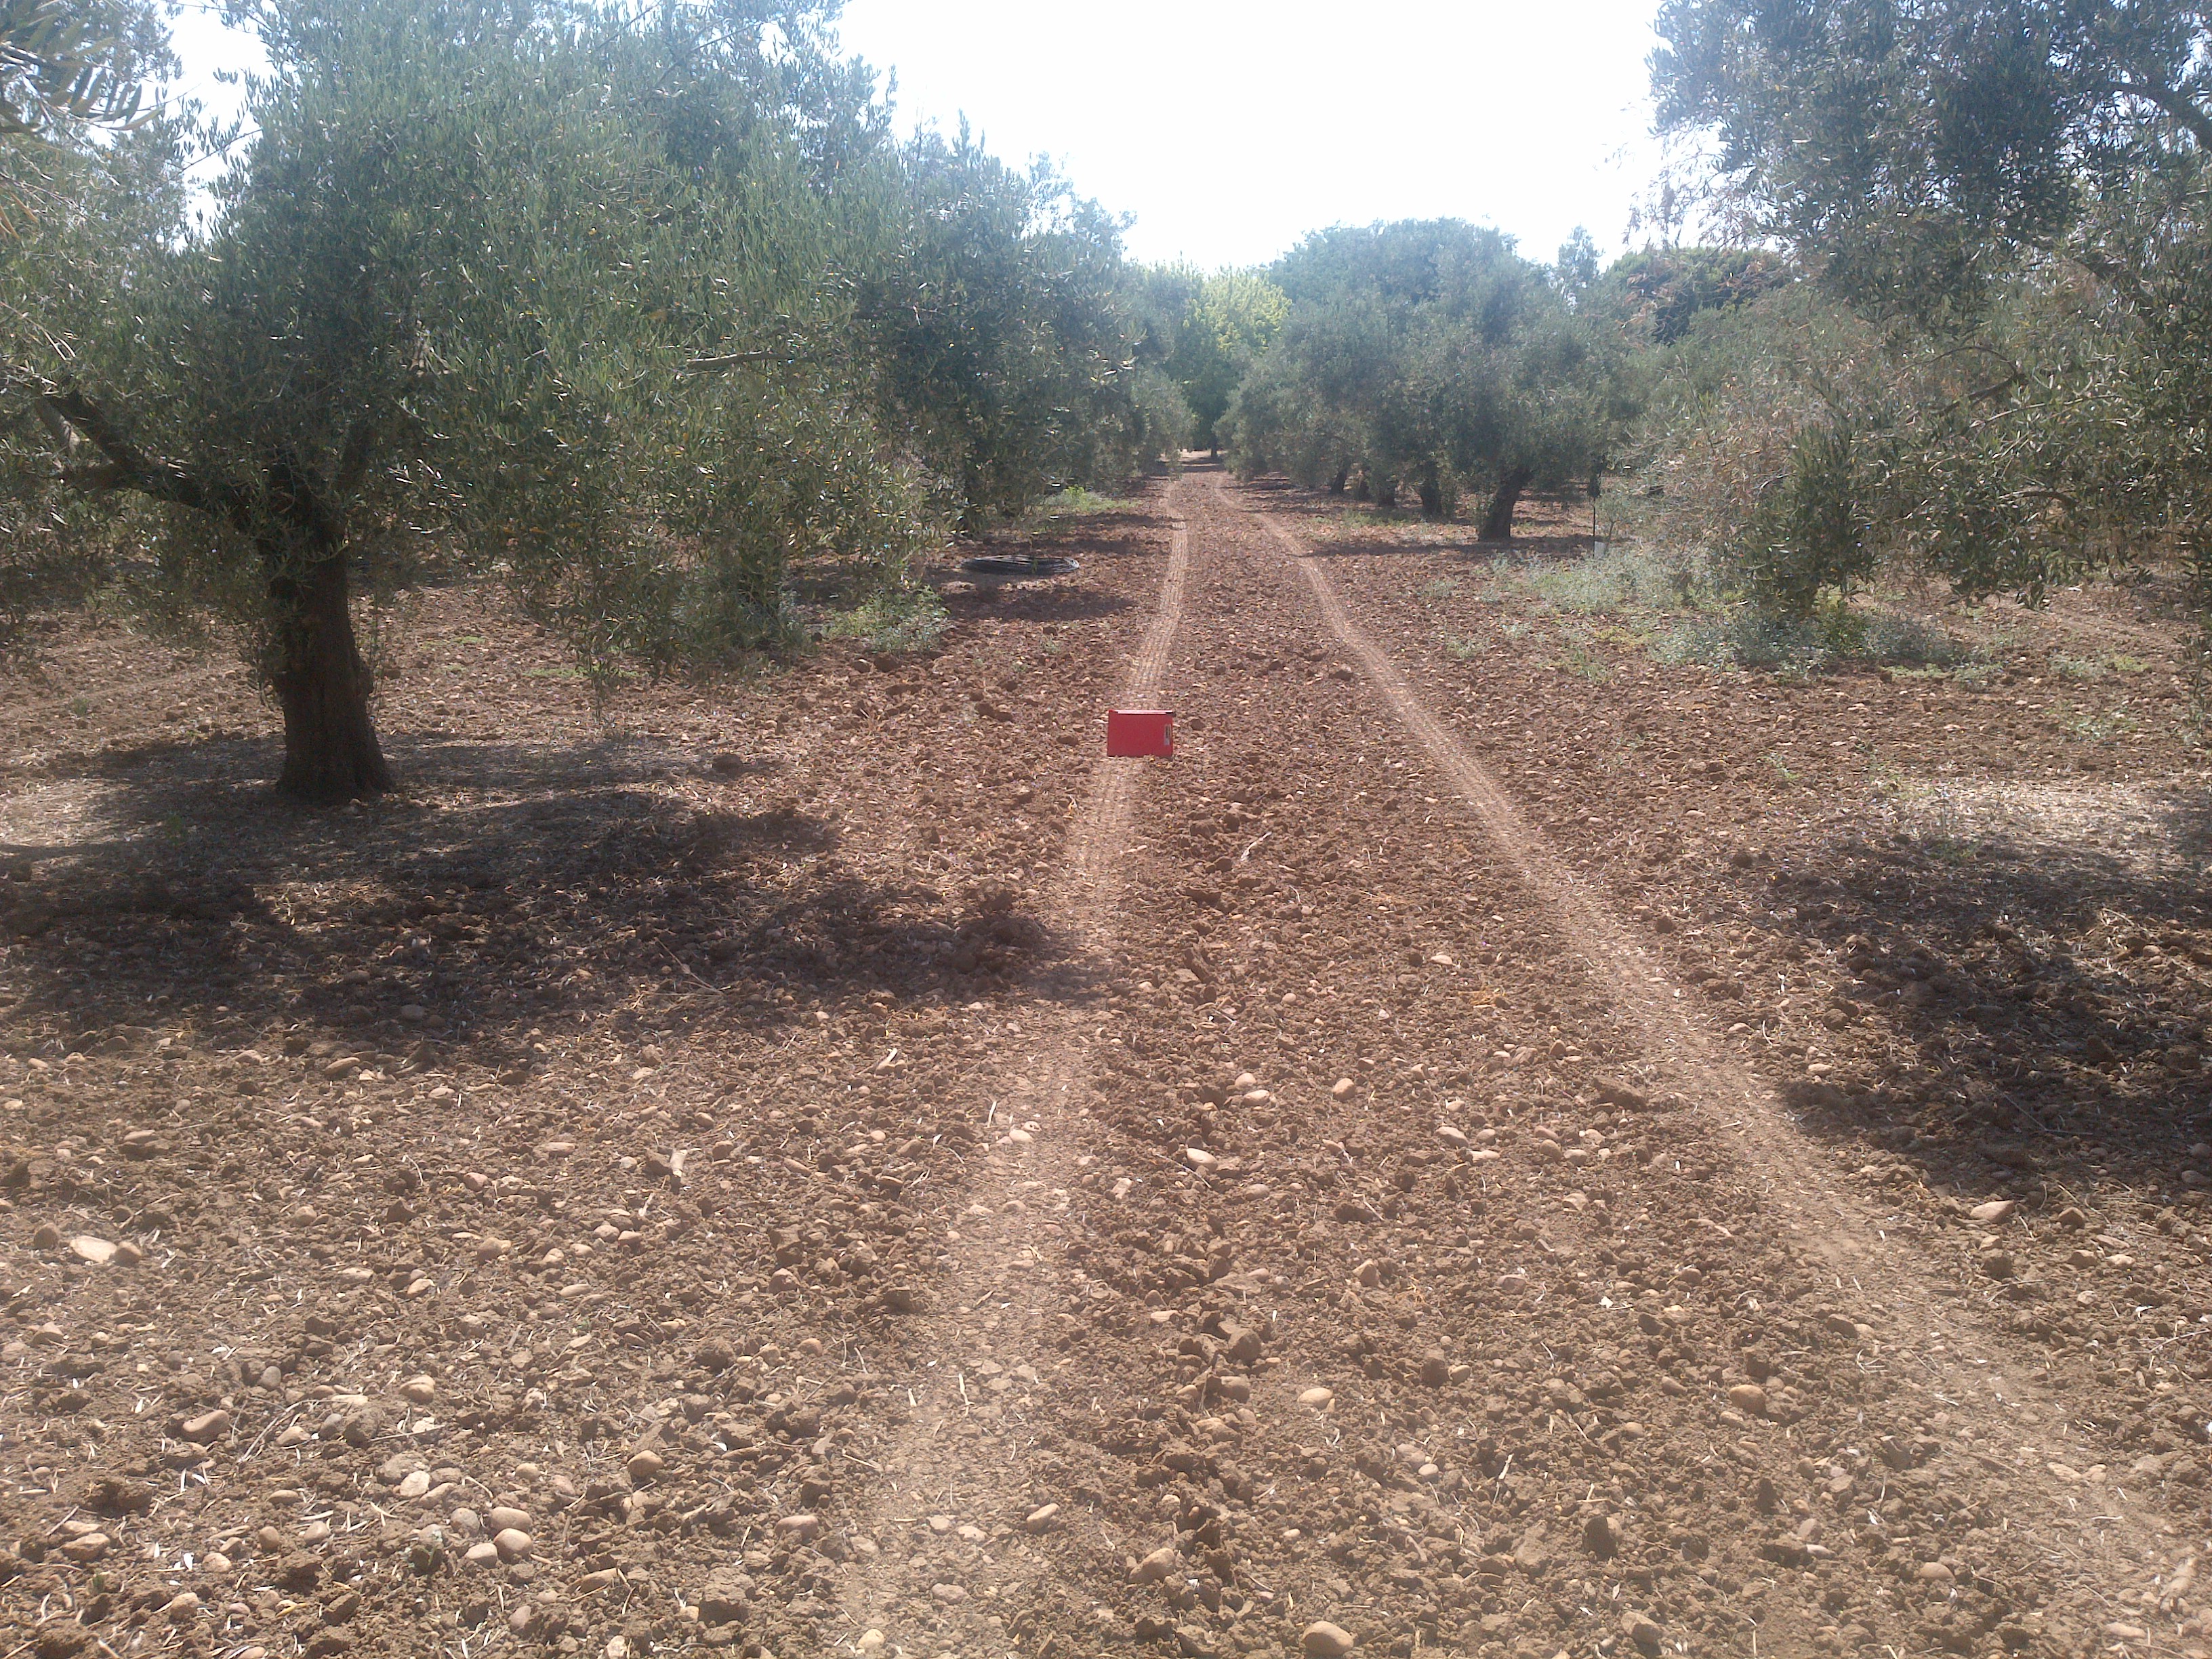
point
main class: Cropland
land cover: Olive groves
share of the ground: 50 - 75 %
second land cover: Other bare soil
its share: > 75 %
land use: Agriculture (excluding fallow land and kitchen gardens)
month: June
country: ES
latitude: 37.5854
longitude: -4.8567
